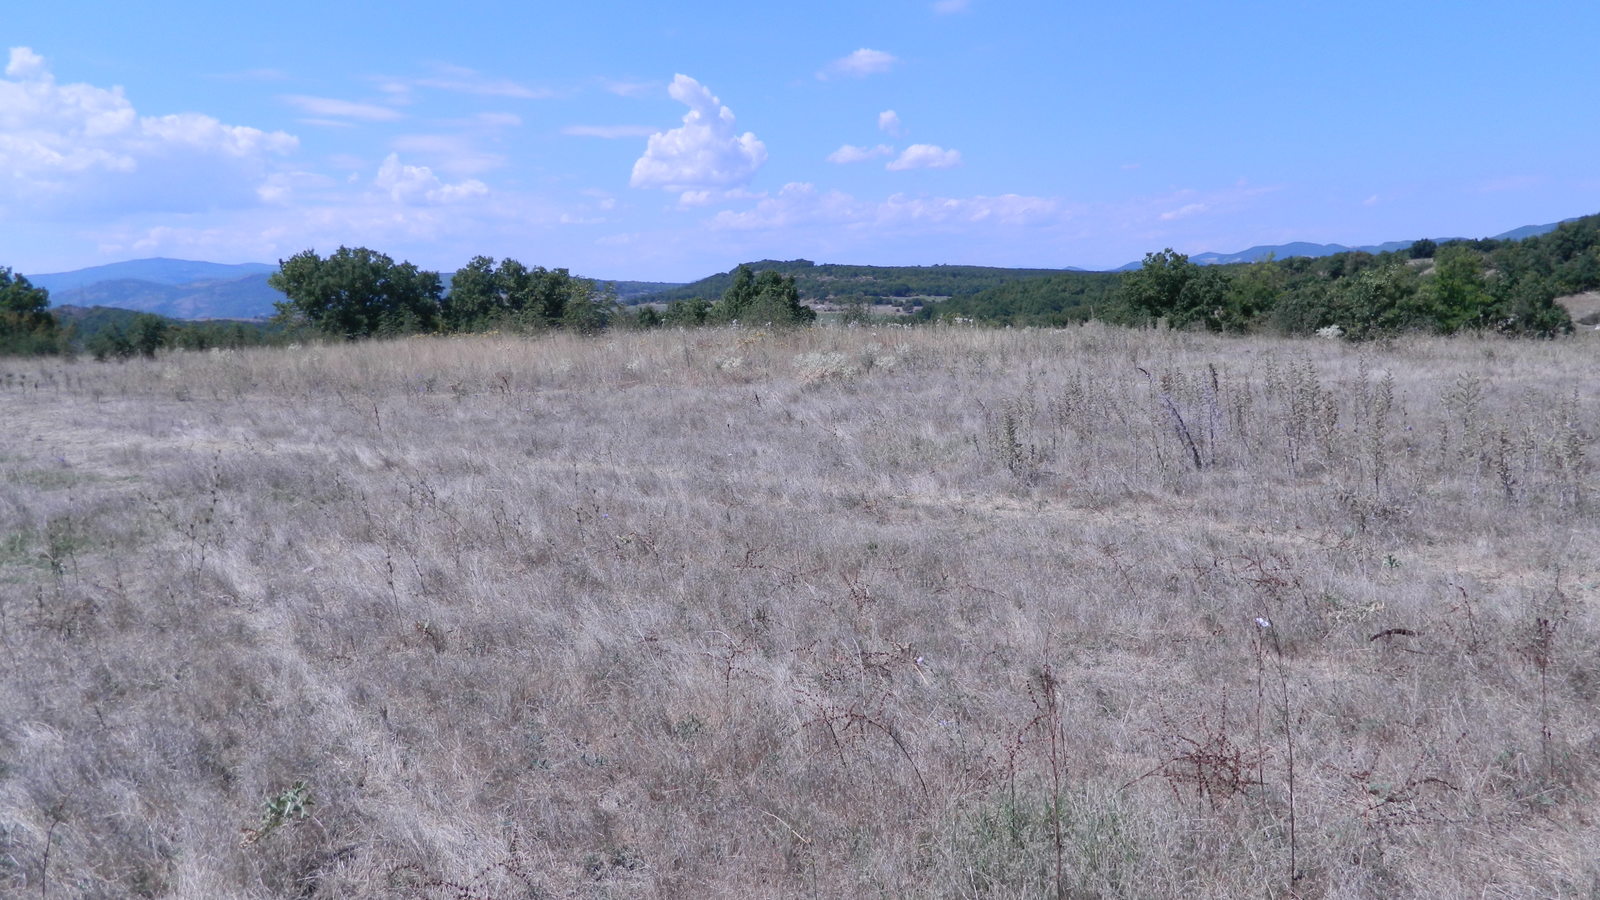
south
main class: Grassland
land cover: Grassland without tree/shrub cover
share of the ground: > 75 %
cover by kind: herbaceous plants 95 %, shrubs 5 %
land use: Agriculture (excluding fallow land and kitchen gardens)
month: August
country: BG
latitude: 41.6540
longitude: 25.7347
